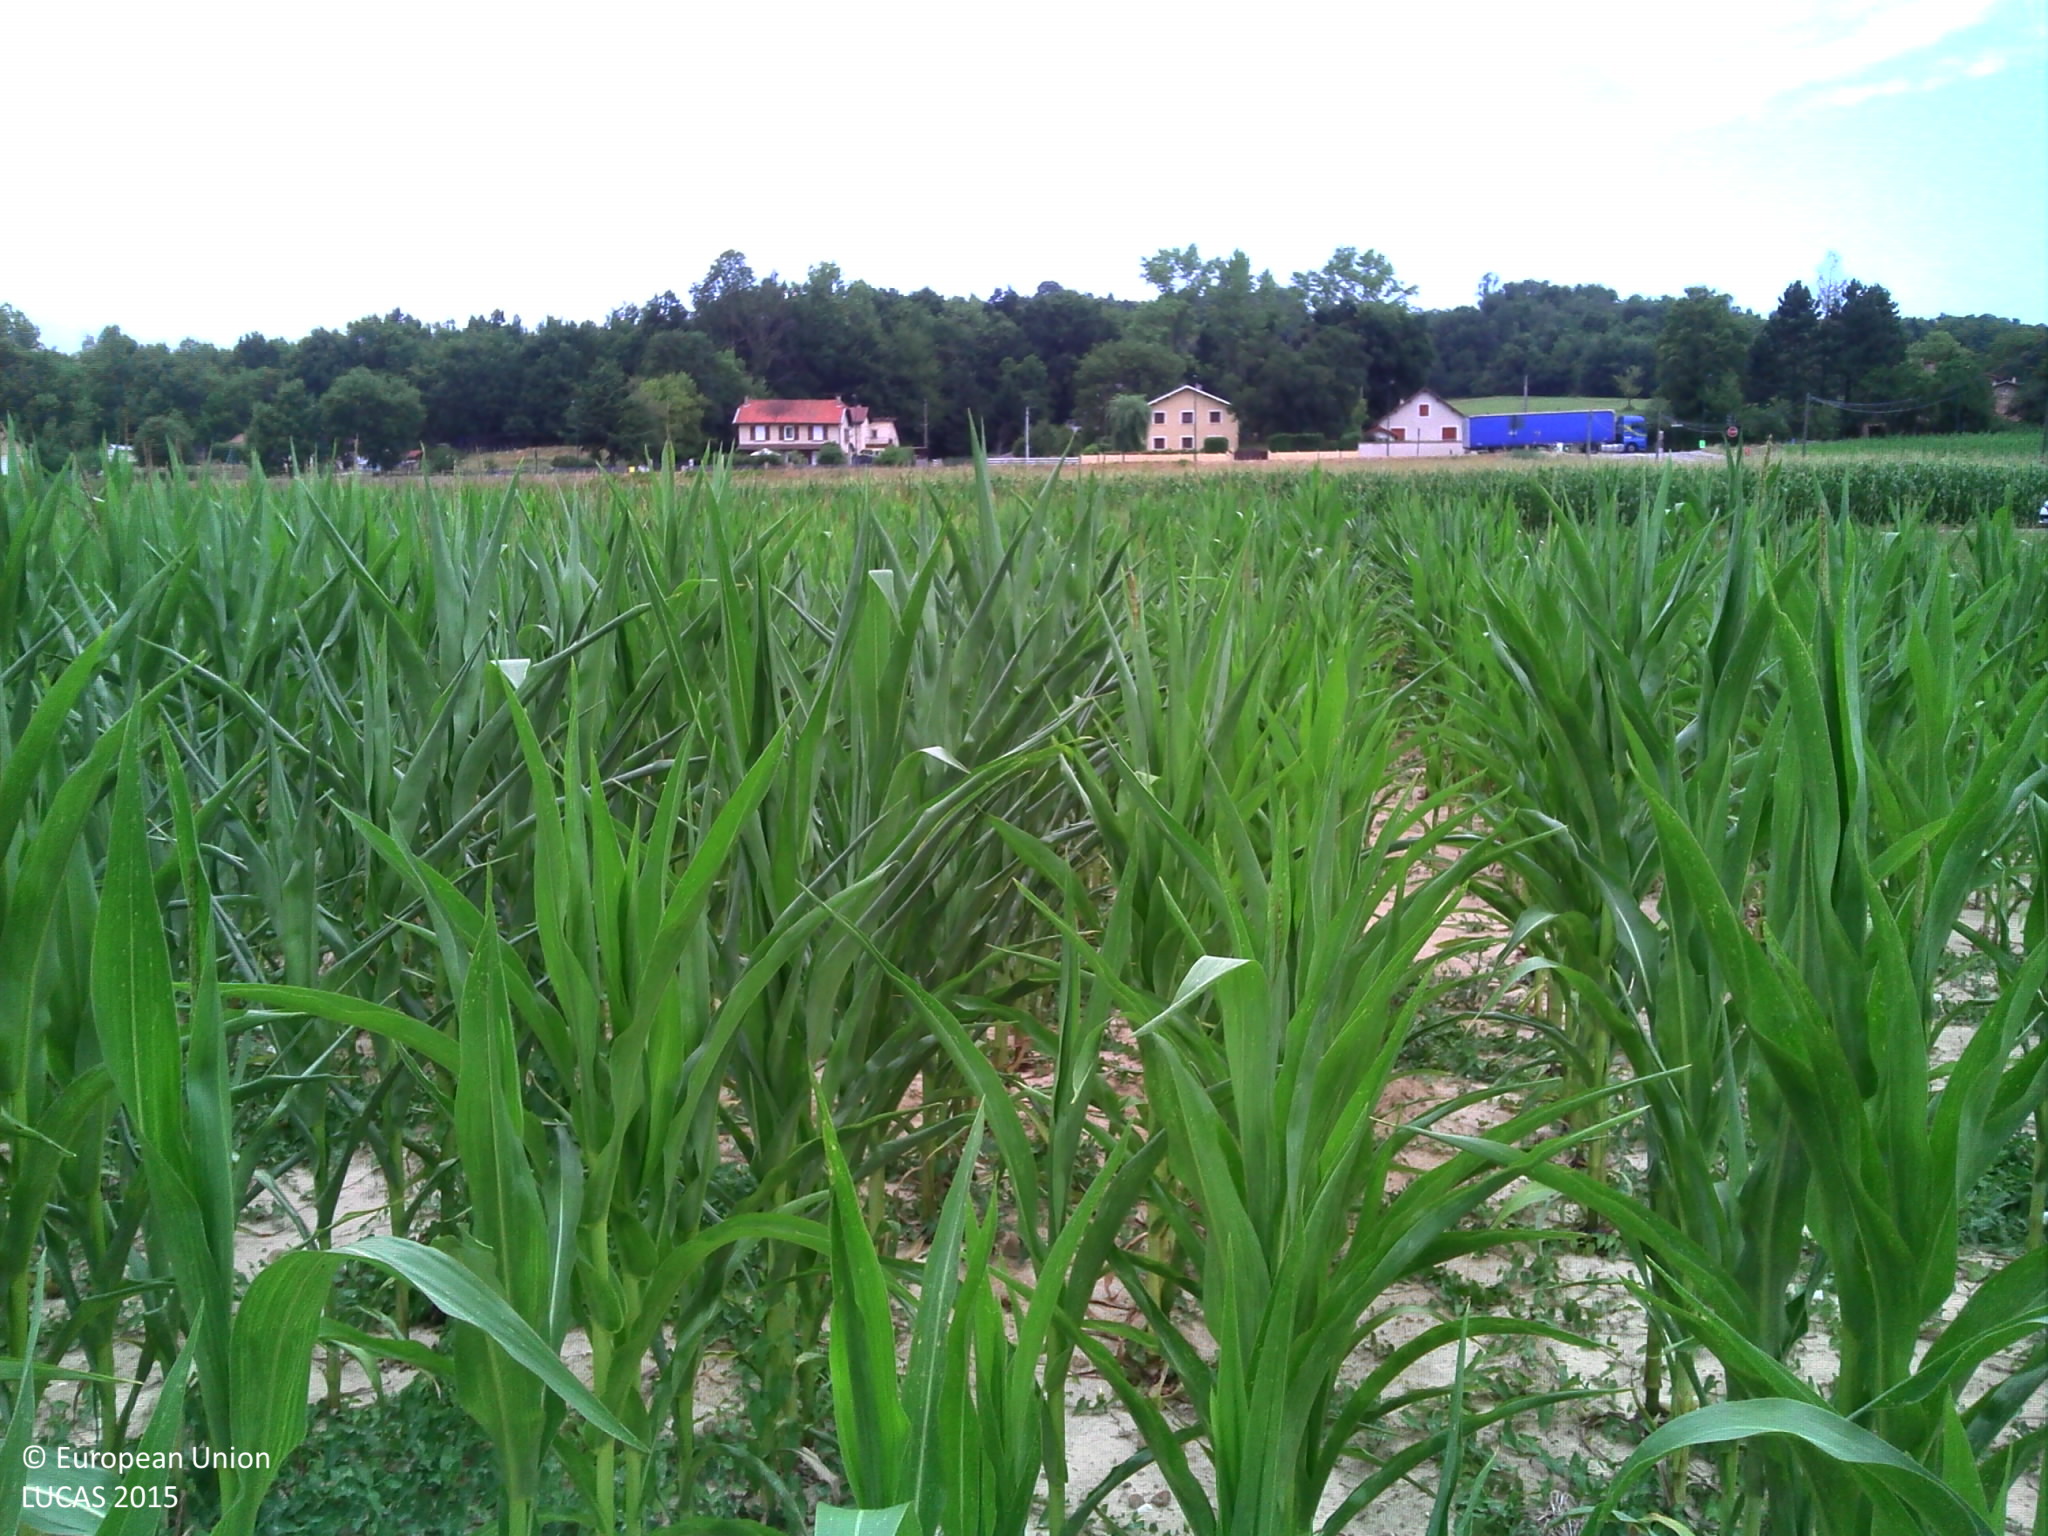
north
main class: Cropland
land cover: Maize
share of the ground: > 75 %
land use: Agriculture (excluding fallow land and kitchen gardens)
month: July
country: FR
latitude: 45.4392
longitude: 4.9804
